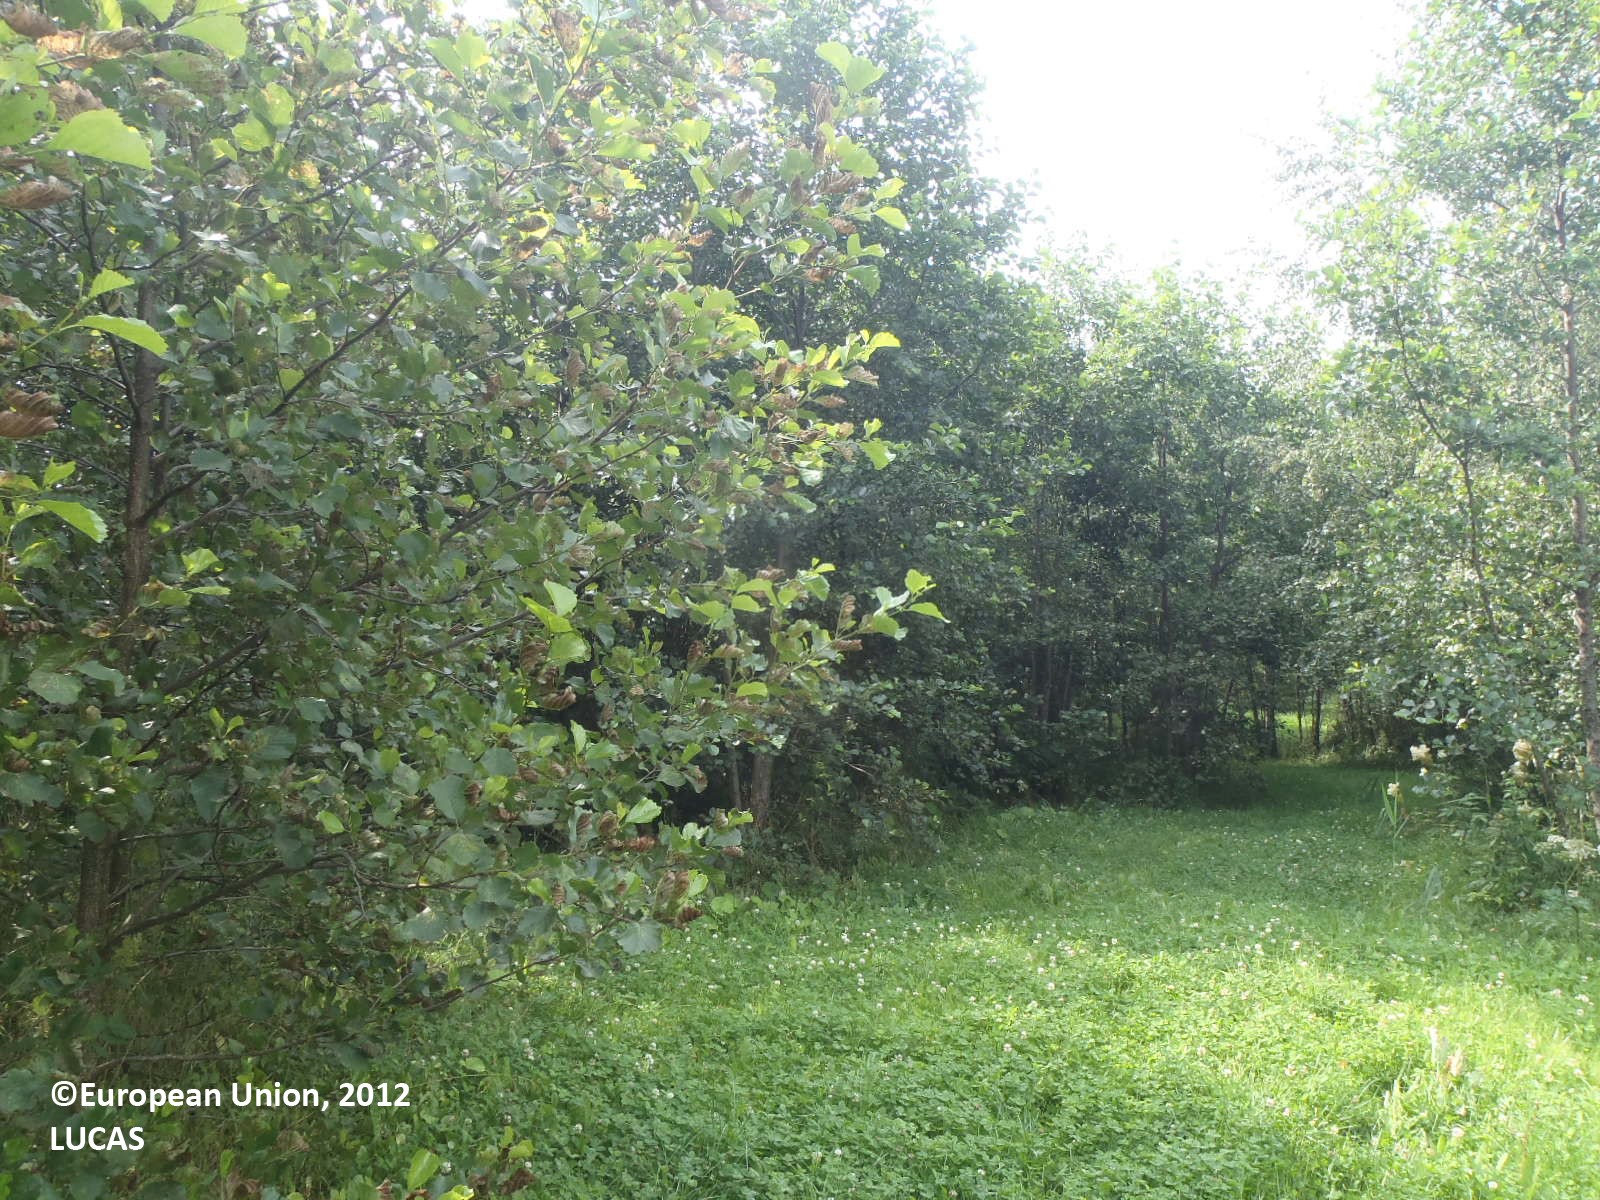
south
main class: Grassland
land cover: Grassland without tree/shrub cover
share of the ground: > 75 %
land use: Amenities, museums, leisure
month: July
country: FI
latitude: 60.5567
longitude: 21.8235
